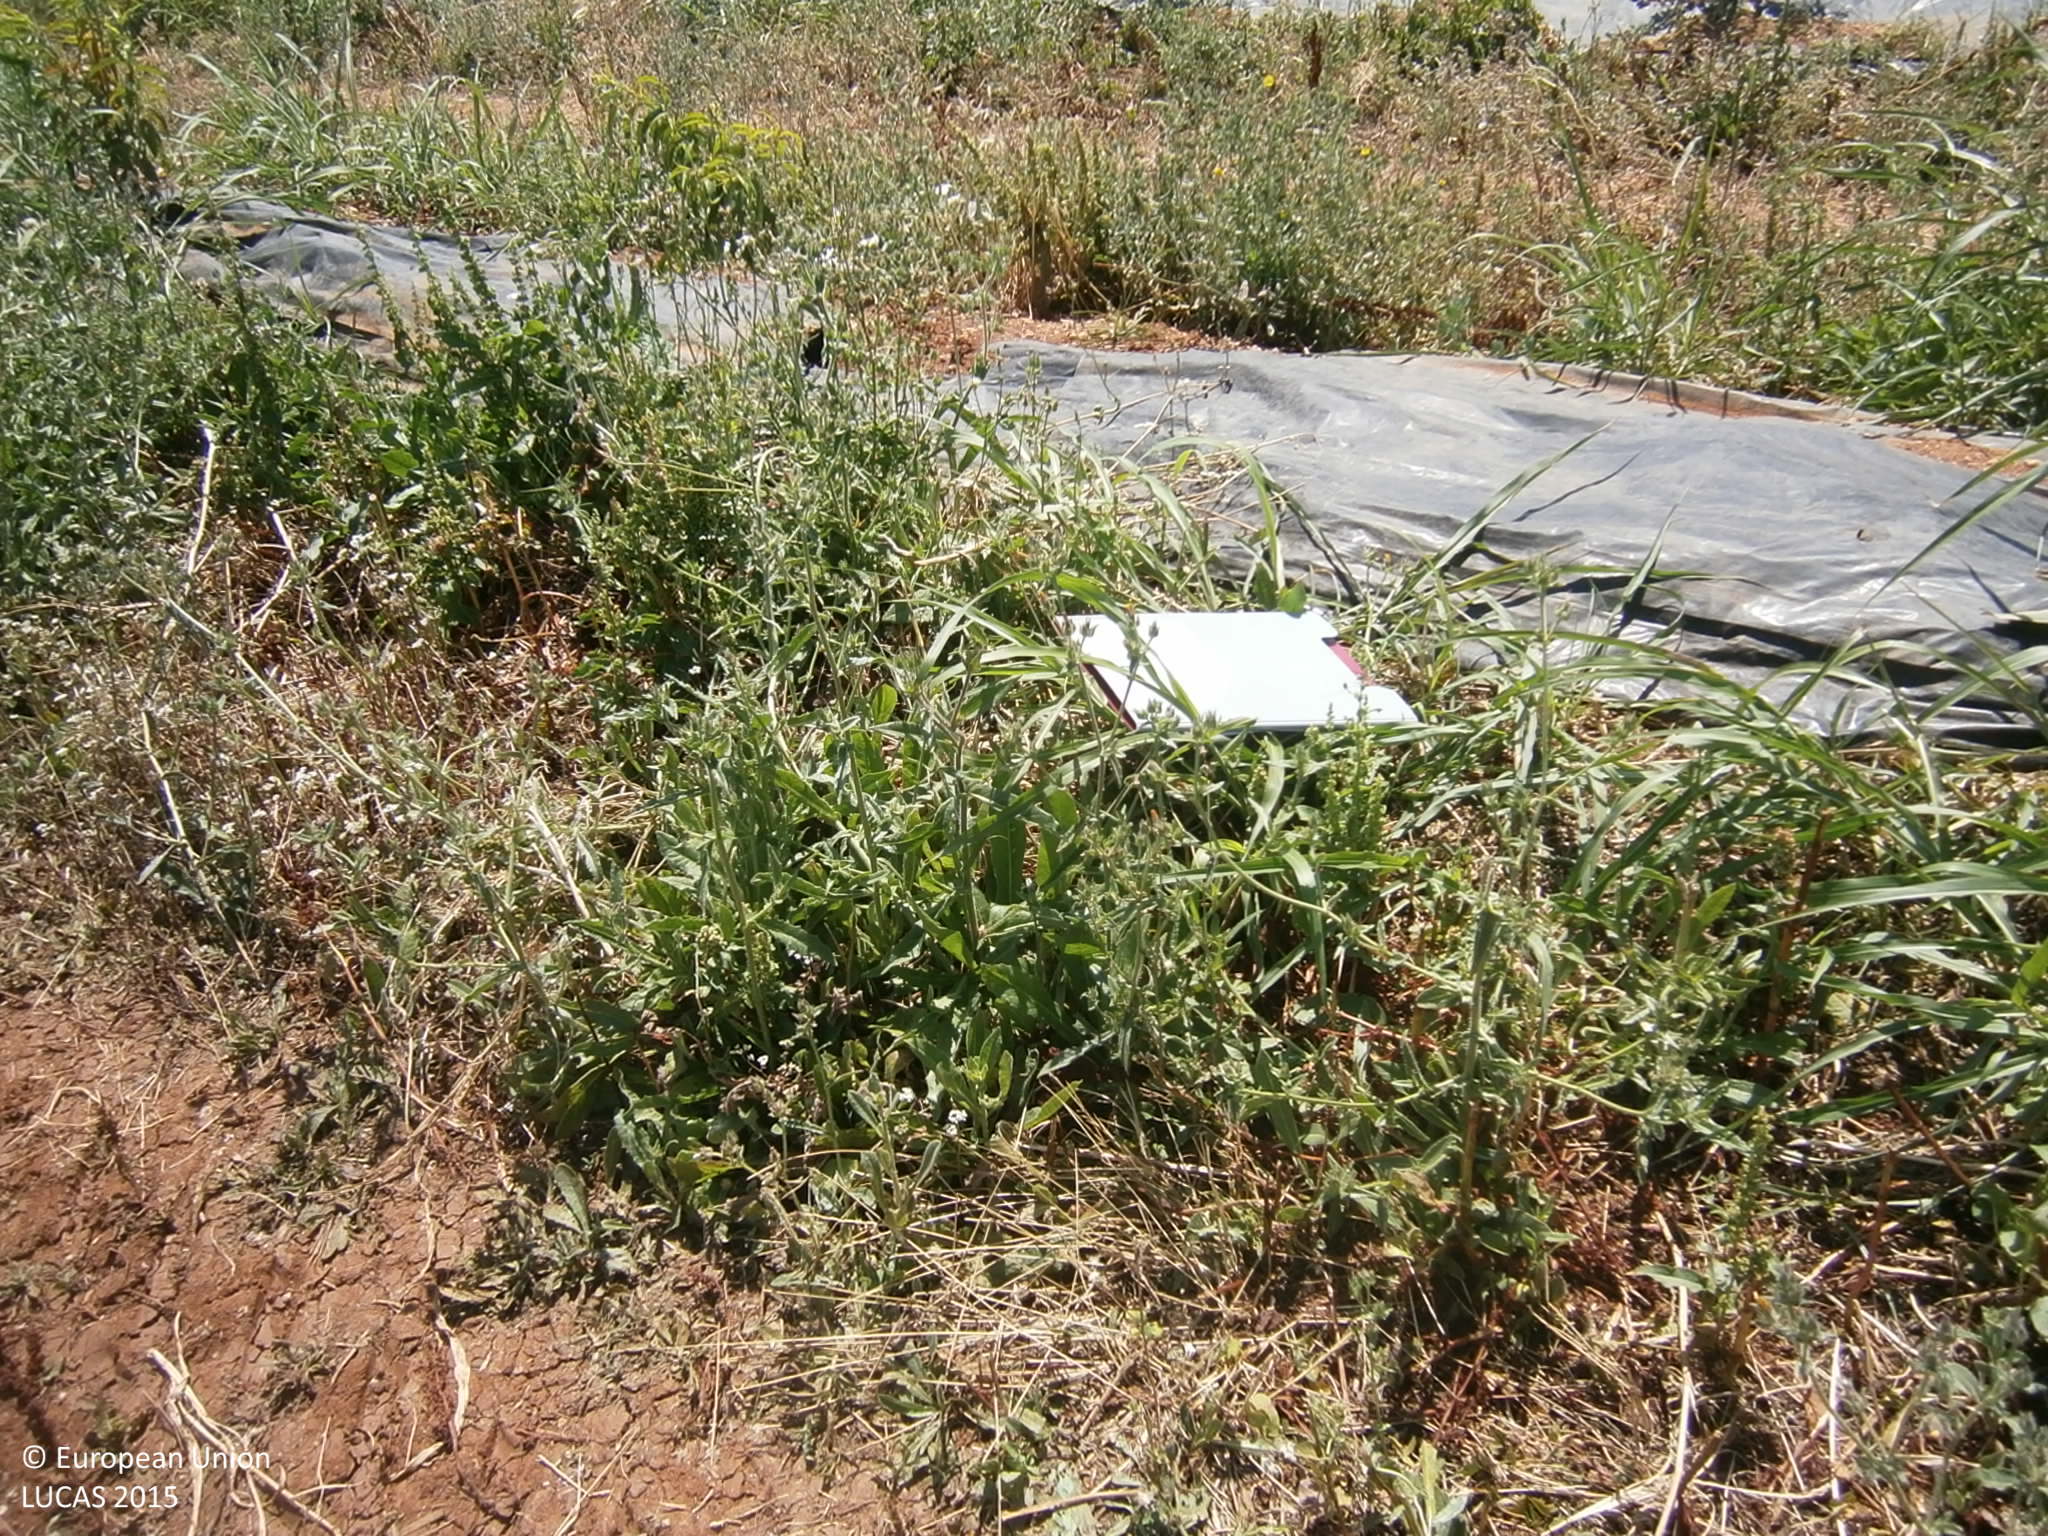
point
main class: Cropland
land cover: Other fruit trees and berries
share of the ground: 50 - 75 %
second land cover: Spontaneously vegetated surfaces
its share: 10 - 25 %
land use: Agriculture (excluding fallow land and kitchen gardens)
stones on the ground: < 10 %
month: June
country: ES
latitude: 38.9370
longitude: -6.6890
